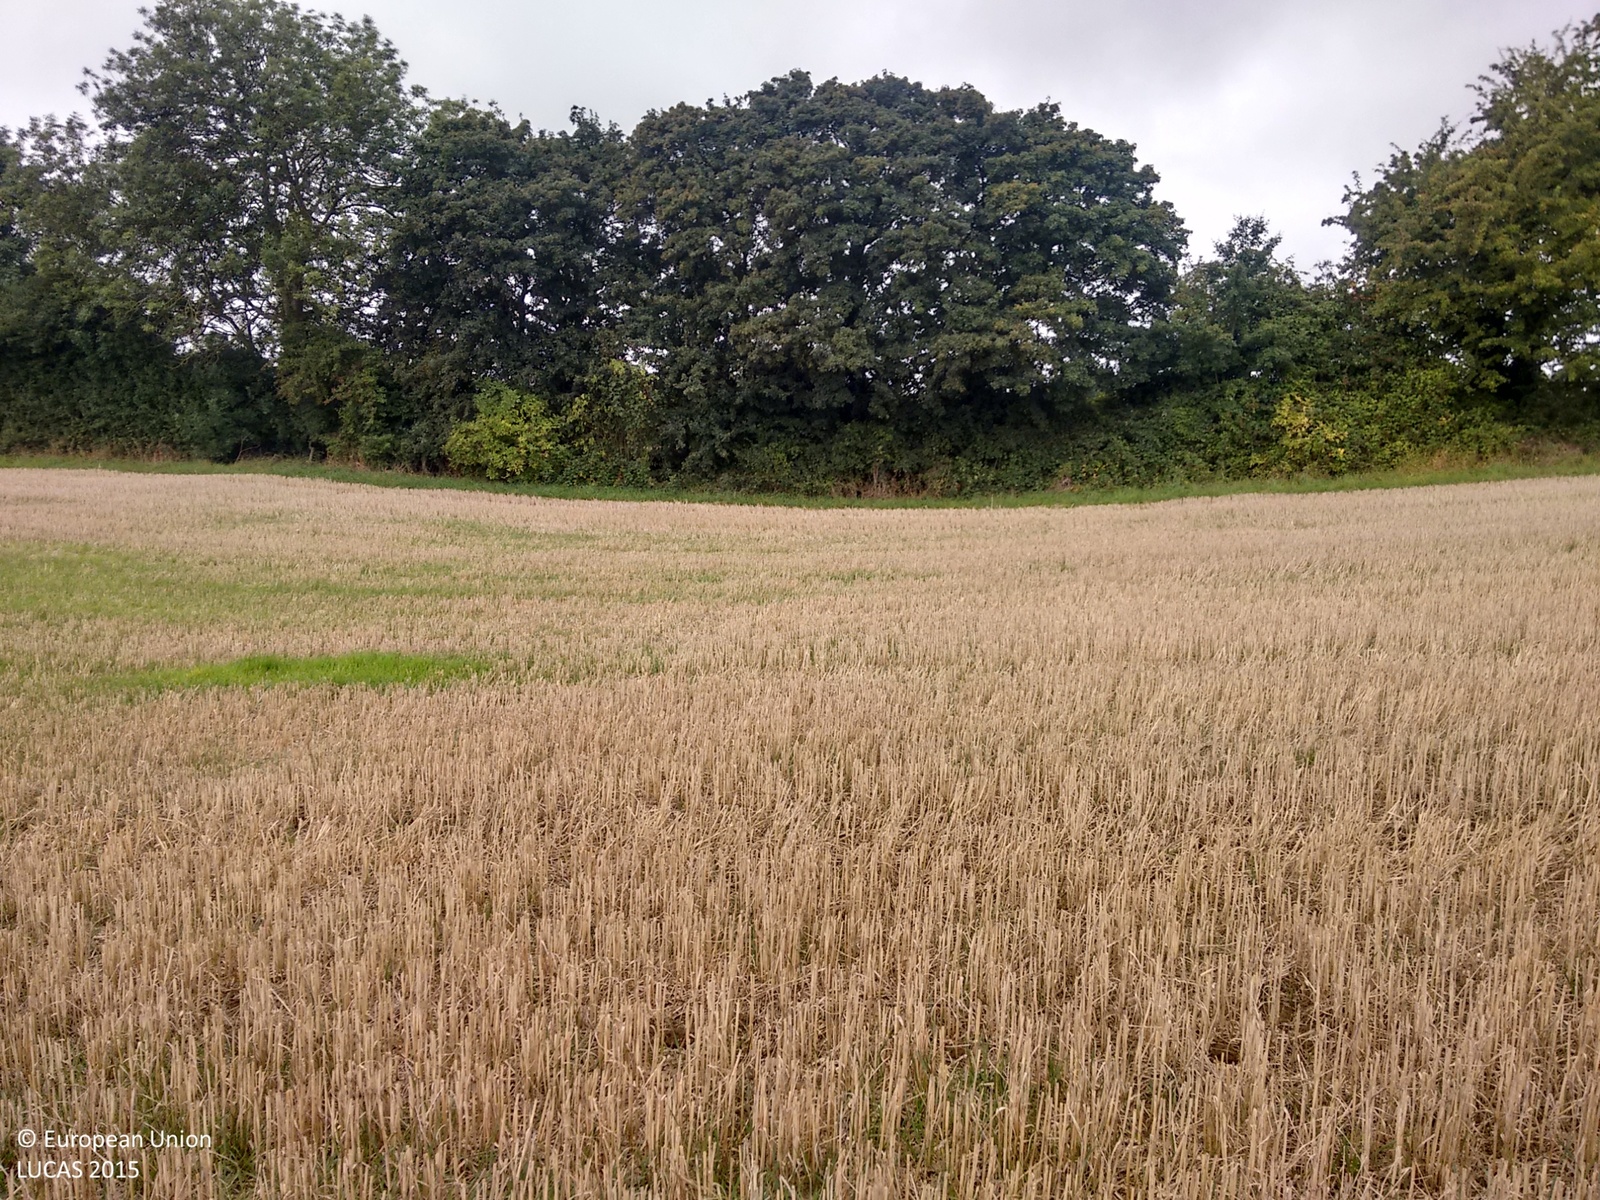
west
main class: Cropland
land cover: Common wheat
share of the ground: > 75 %
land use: Agriculture (excluding fallow land and kitchen gardens)
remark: Harvested field
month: September
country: GB
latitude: 52.3358
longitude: 1.3945
